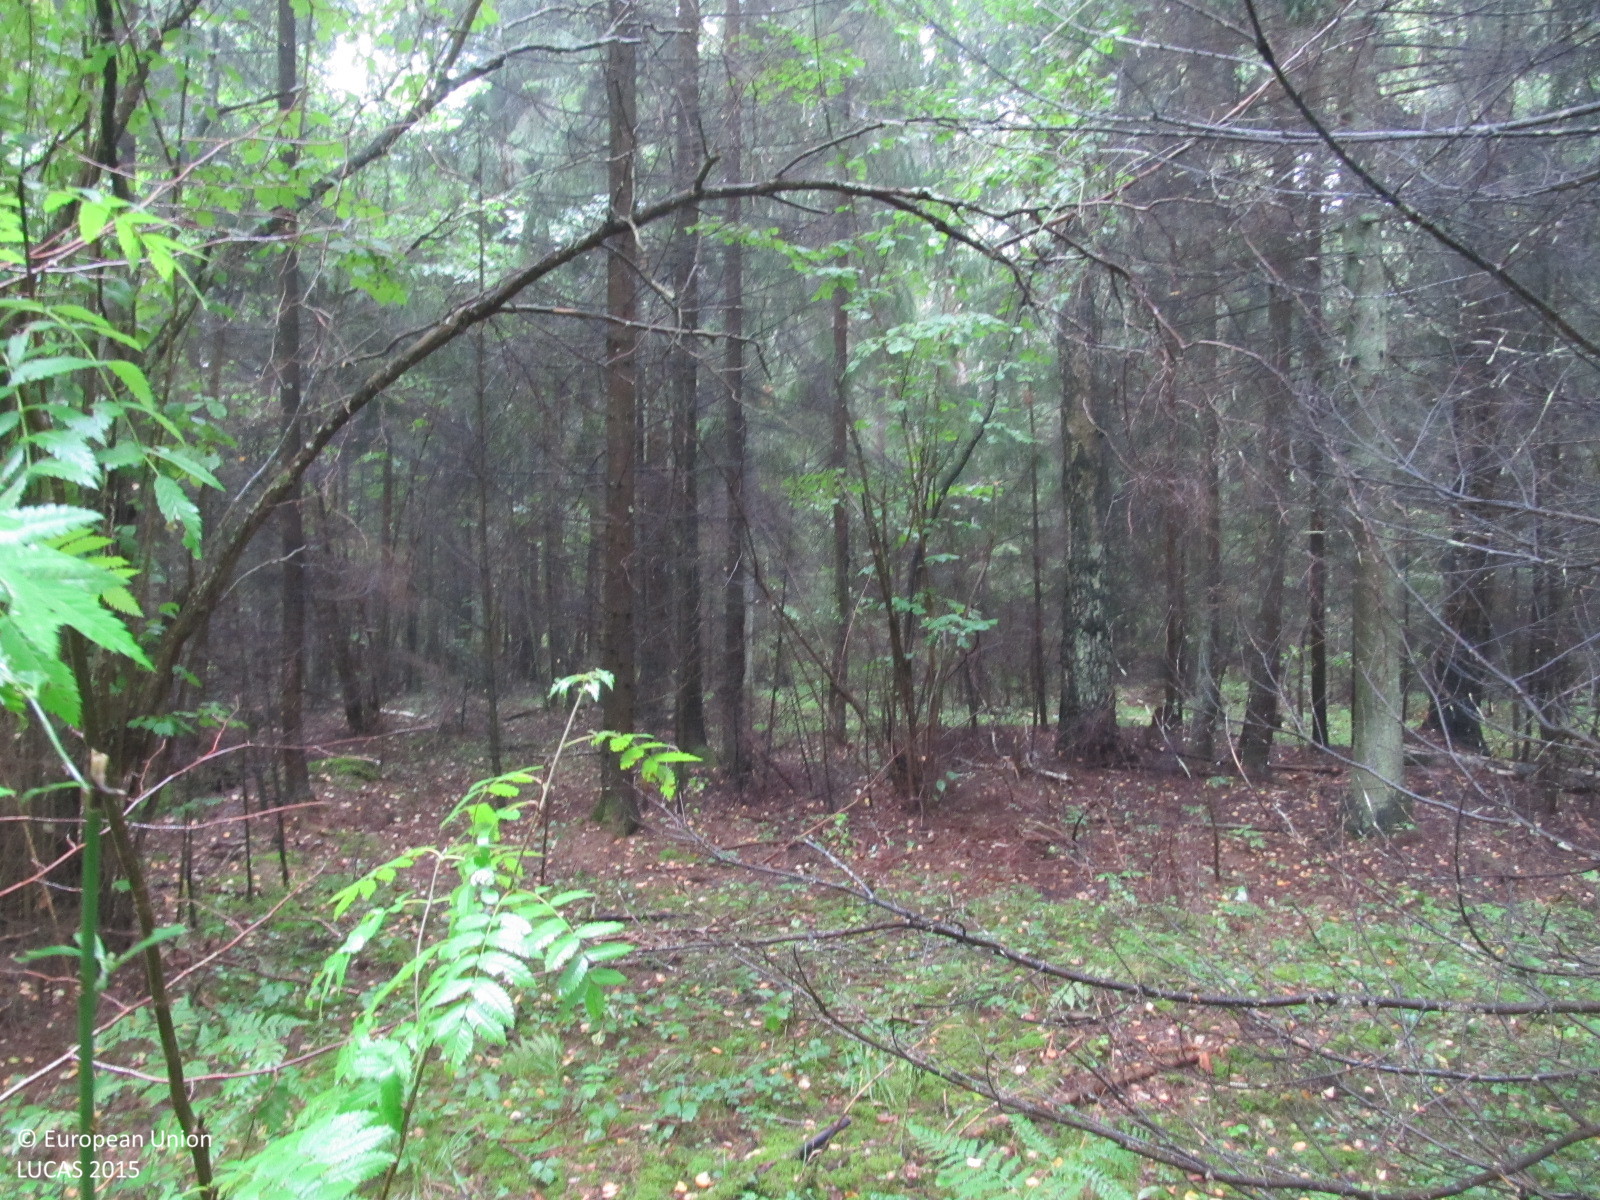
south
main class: Woodland
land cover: Spruce dominated mixed woodland
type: hemiboreal forest and nemoral coniferous forest and mixed broadleaved-coniferous forest
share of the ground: > 75 %
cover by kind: coniferous forest trees 65 %, broadleaved forest trees 30 %, herbaceous plants 5 %
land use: Forestry
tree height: > 5 m
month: September
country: LT
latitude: 56.0538
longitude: 23.1570
